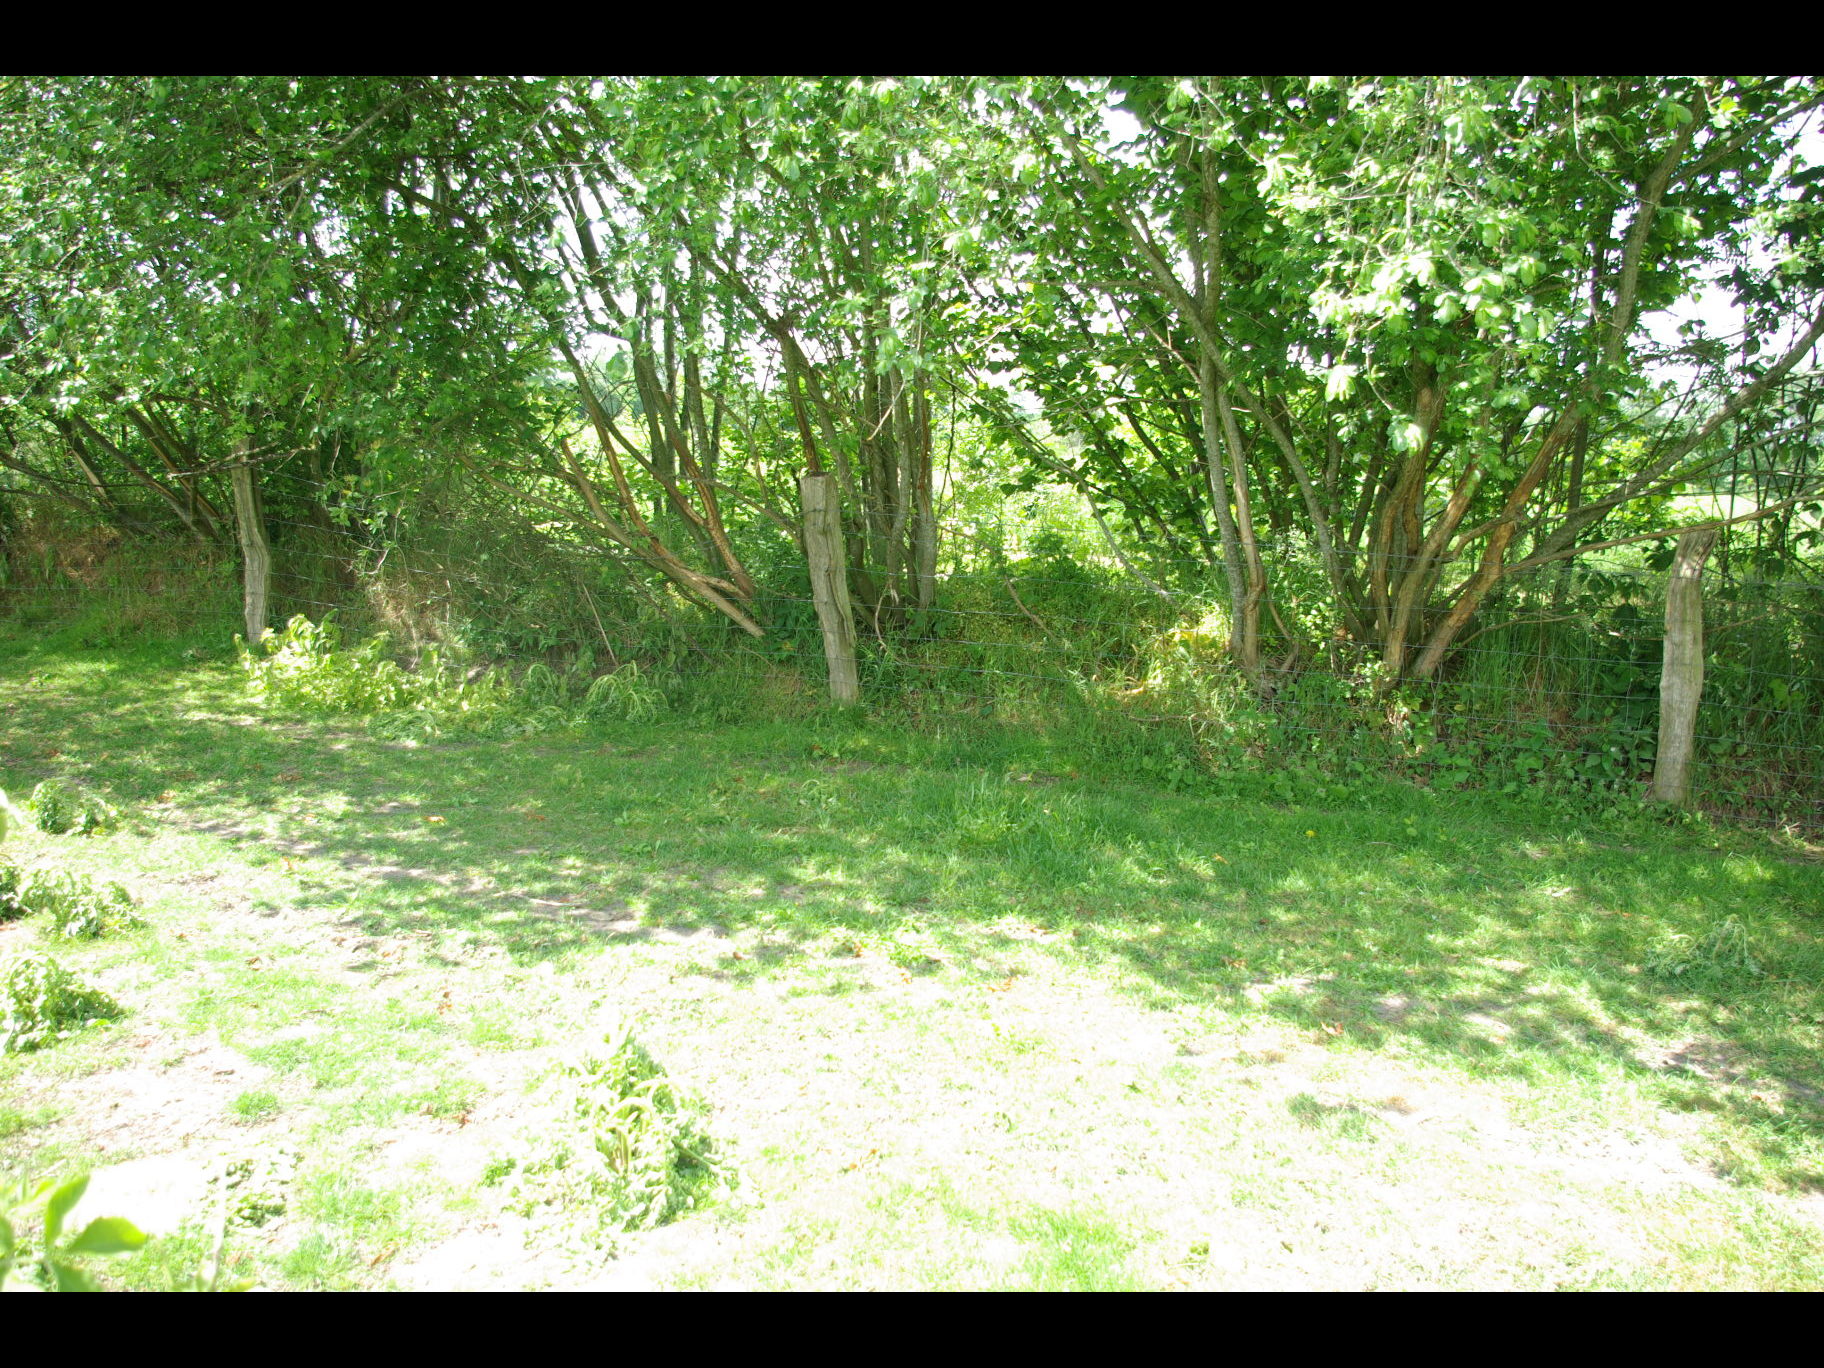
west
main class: Grassland
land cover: Grassland without tree/shrub cover
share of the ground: > 75 %
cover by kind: herbaceous plants 80 %, unconsolidated bare surface 20 %
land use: Agriculture (excluding fallow land and kitchen gardens)
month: June
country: DE
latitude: 54.0848
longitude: 9.8931
